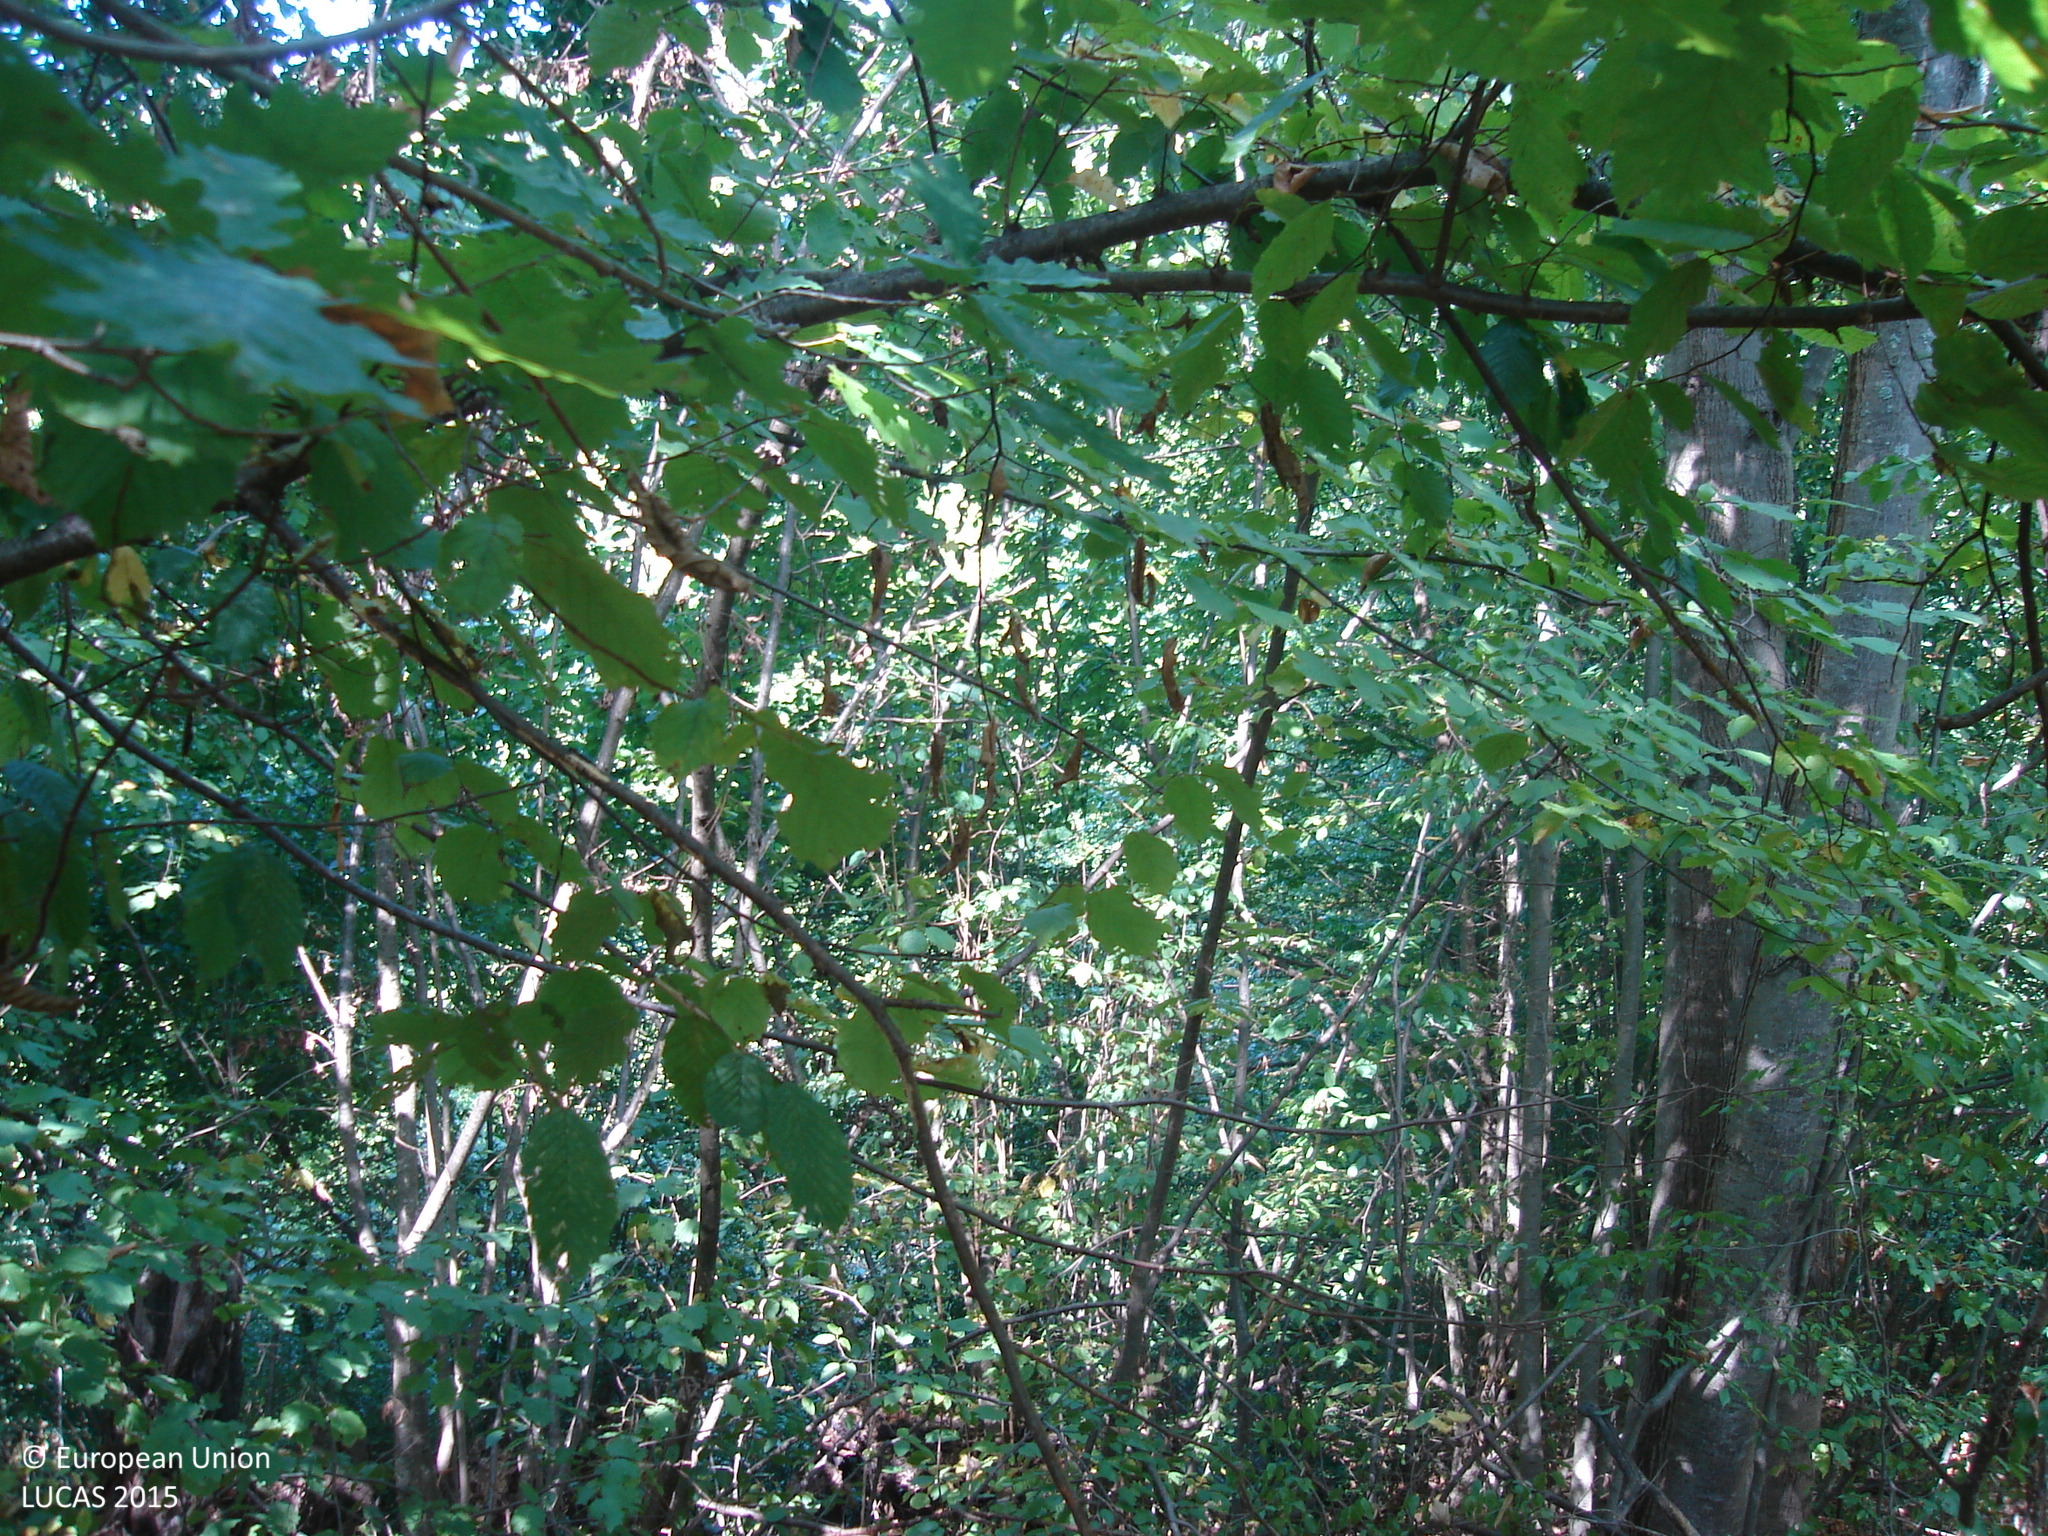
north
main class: Woodland
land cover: Broadleaved woodland
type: mesophytic deciduous forest
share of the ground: > 75 %
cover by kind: broadleaved forest trees 95 %, consolidated bare surface 5 %
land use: Forestry
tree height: > 5 m
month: September
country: BG
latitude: 42.8386
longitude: 23.9315
